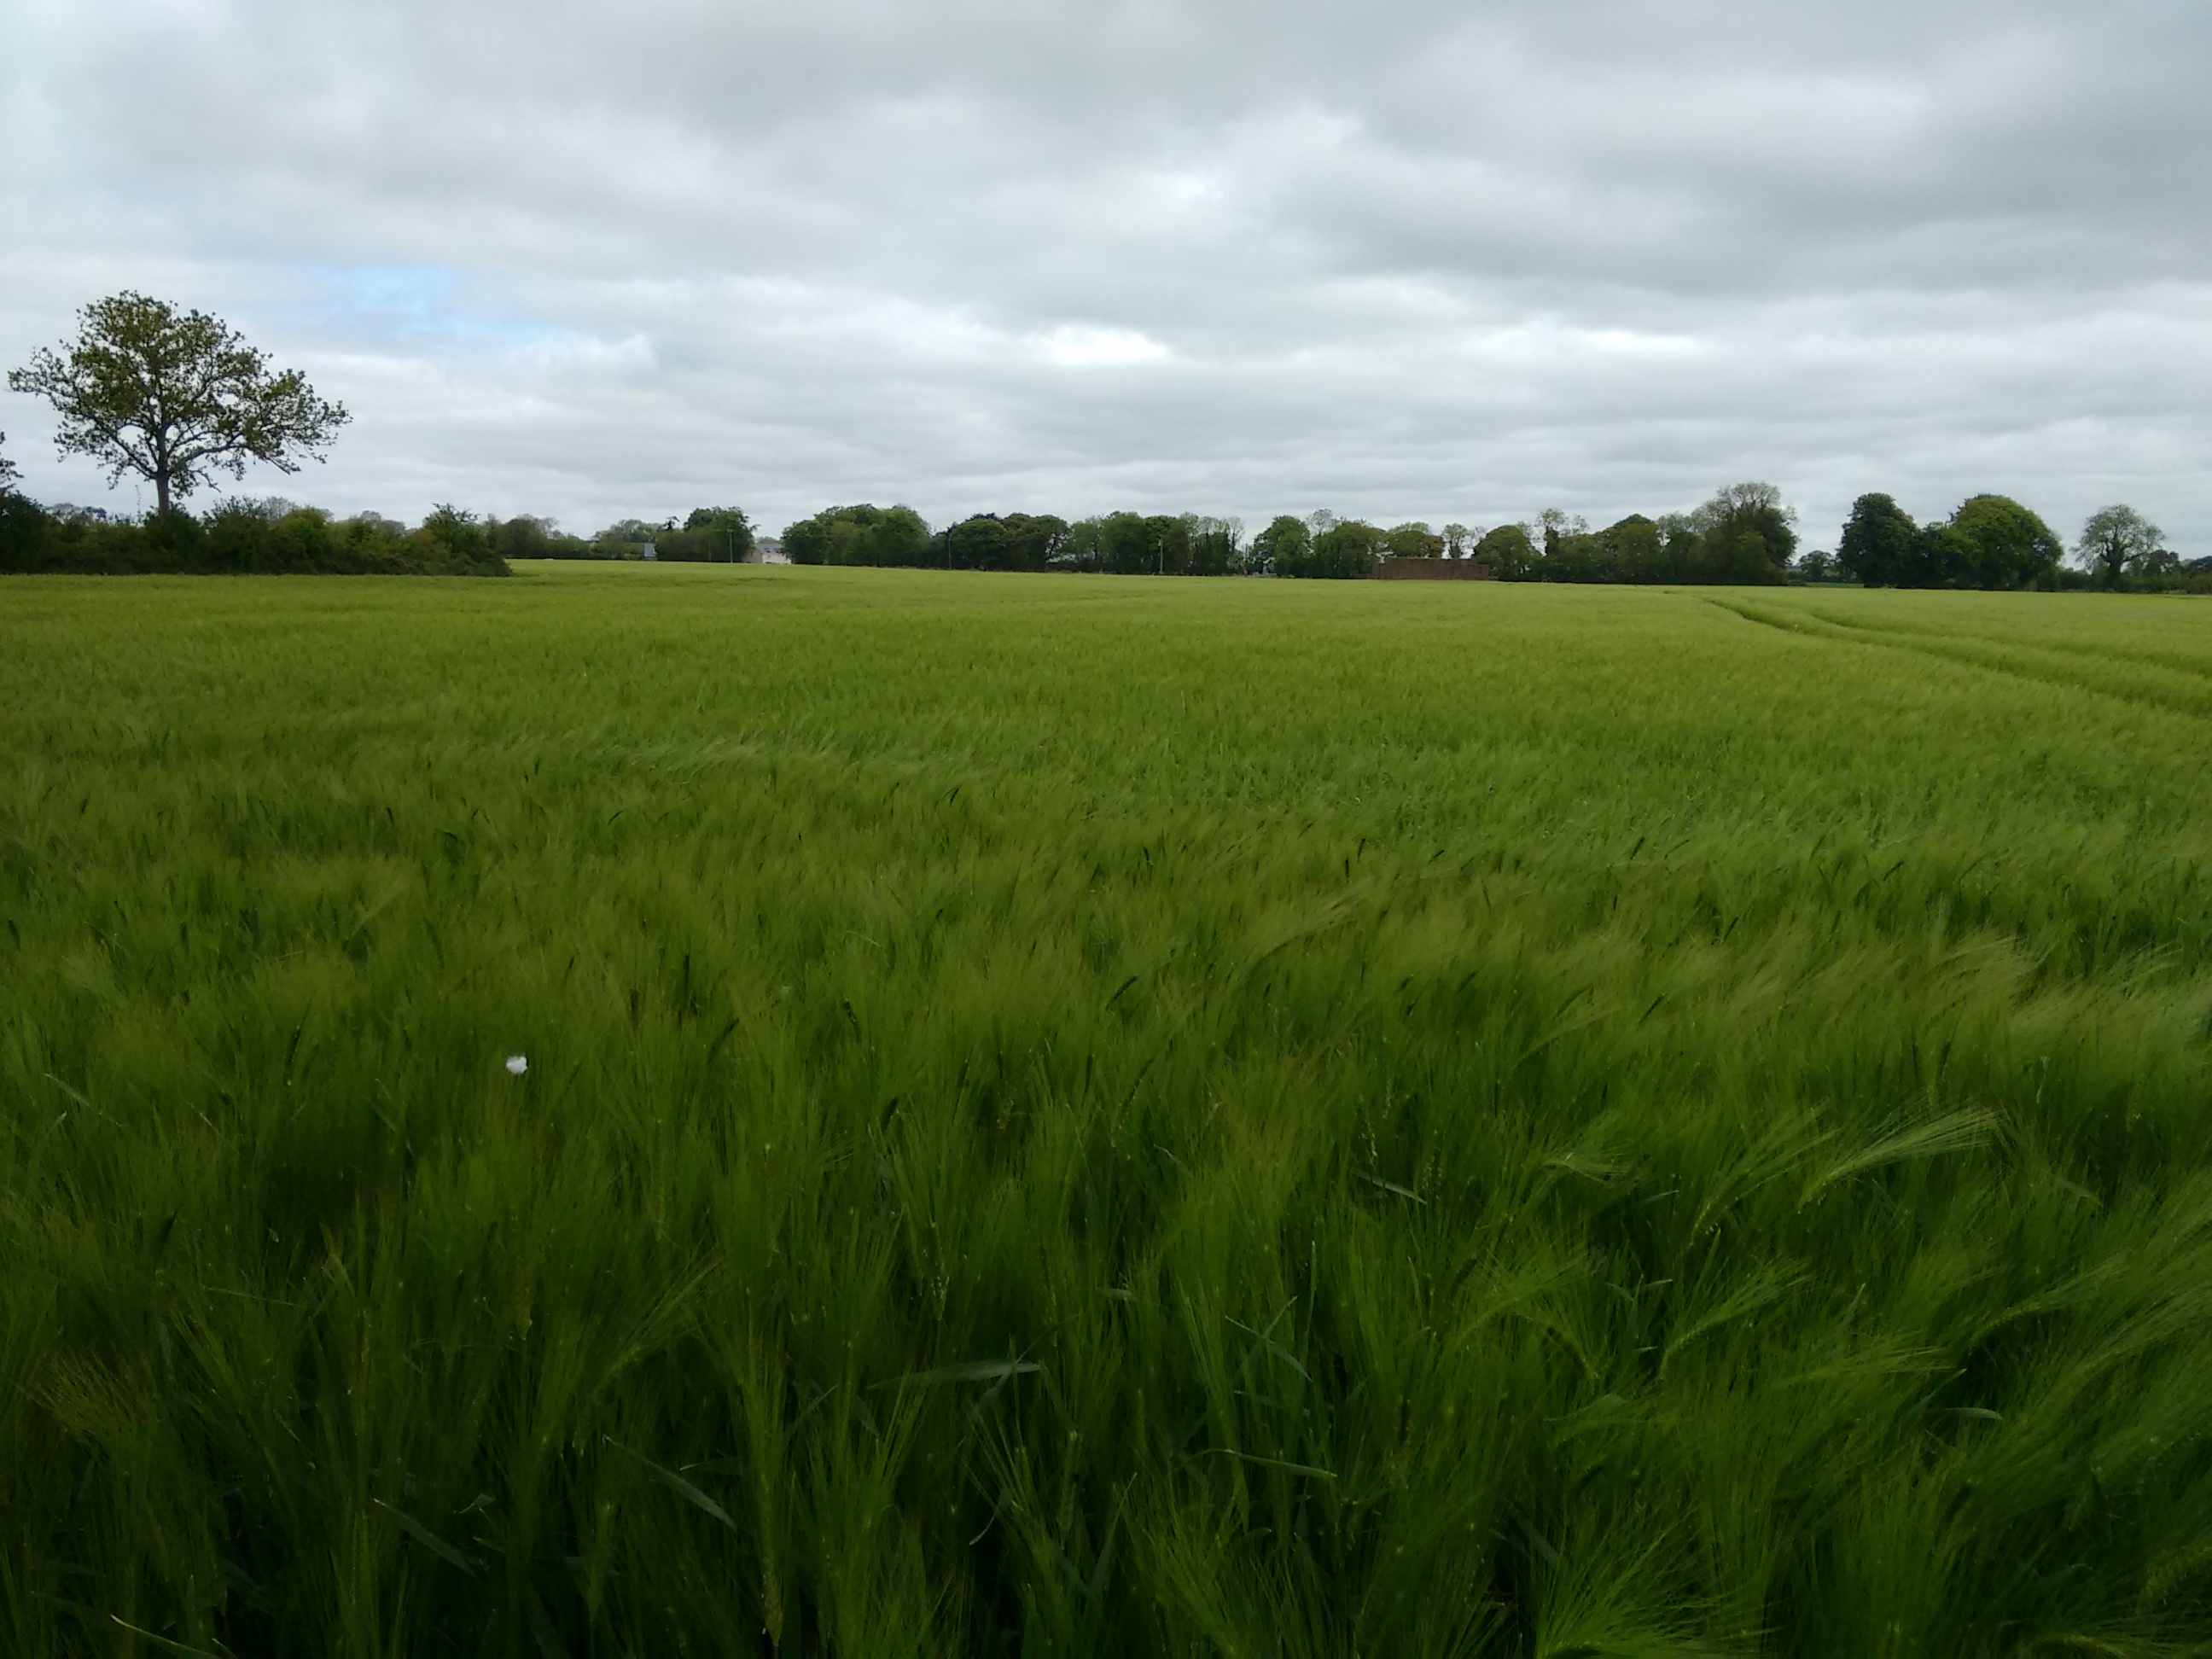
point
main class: Cropland
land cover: Barley
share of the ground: > 75 %
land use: Agriculture (excluding fallow land and kitchen gardens)
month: May
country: IE
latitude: 53.4856
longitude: -6.6637
